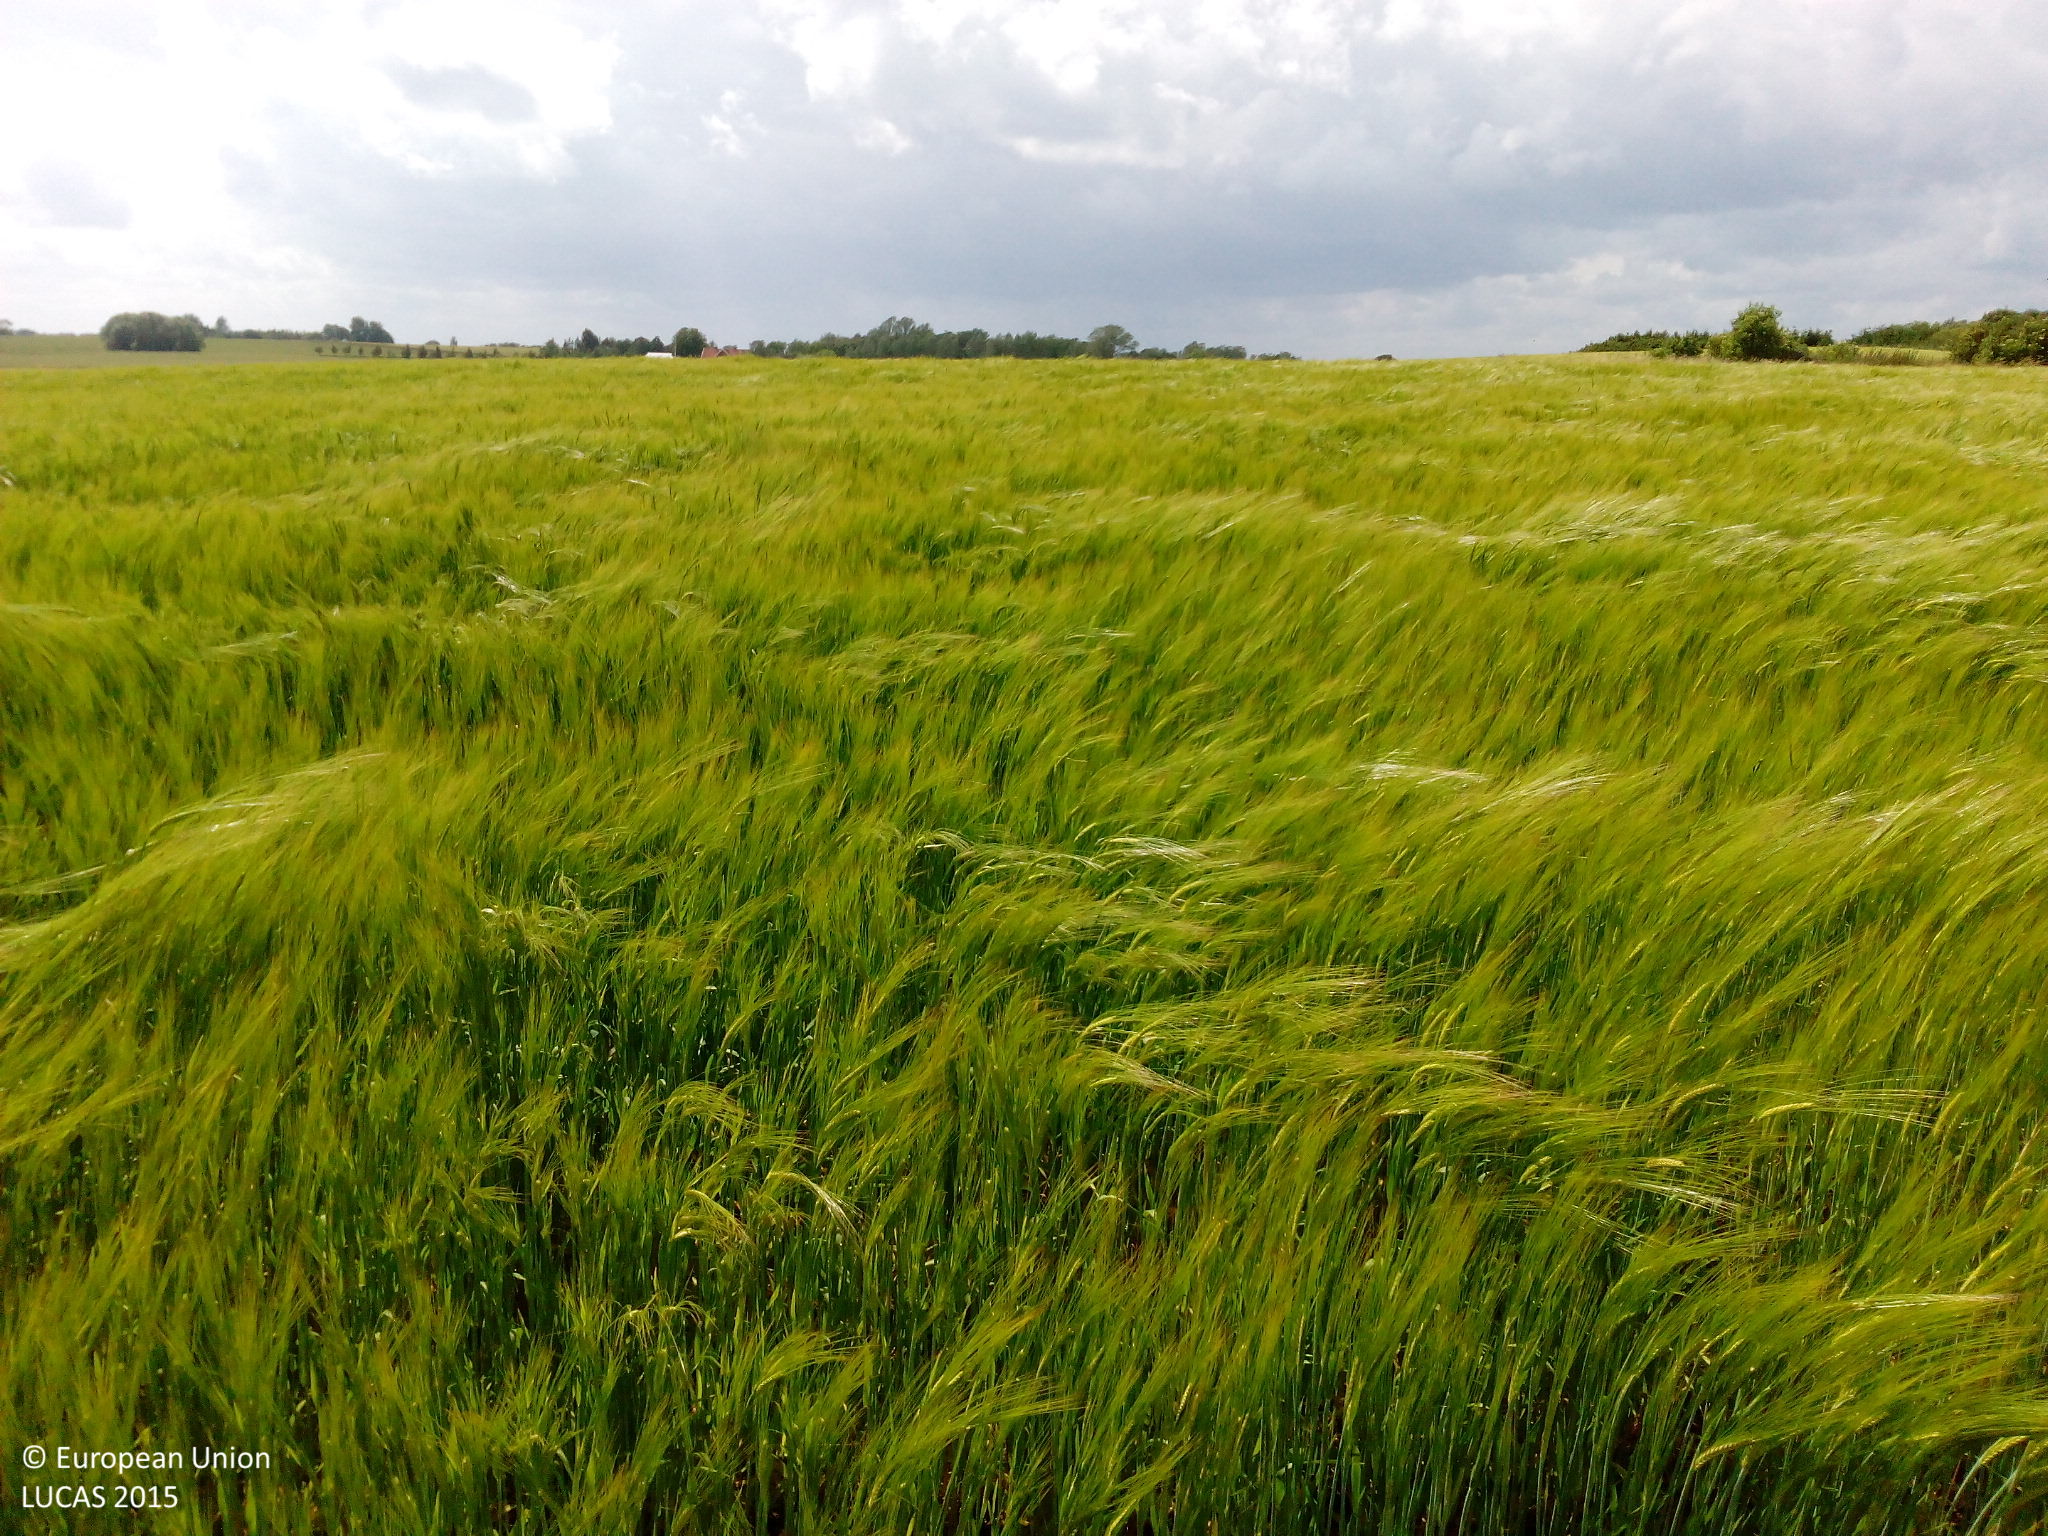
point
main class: Cropland
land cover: Barley
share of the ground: > 75 %
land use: Agriculture (excluding fallow land and kitchen gardens)
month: July
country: DK
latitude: 55.2287
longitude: 11.2725
